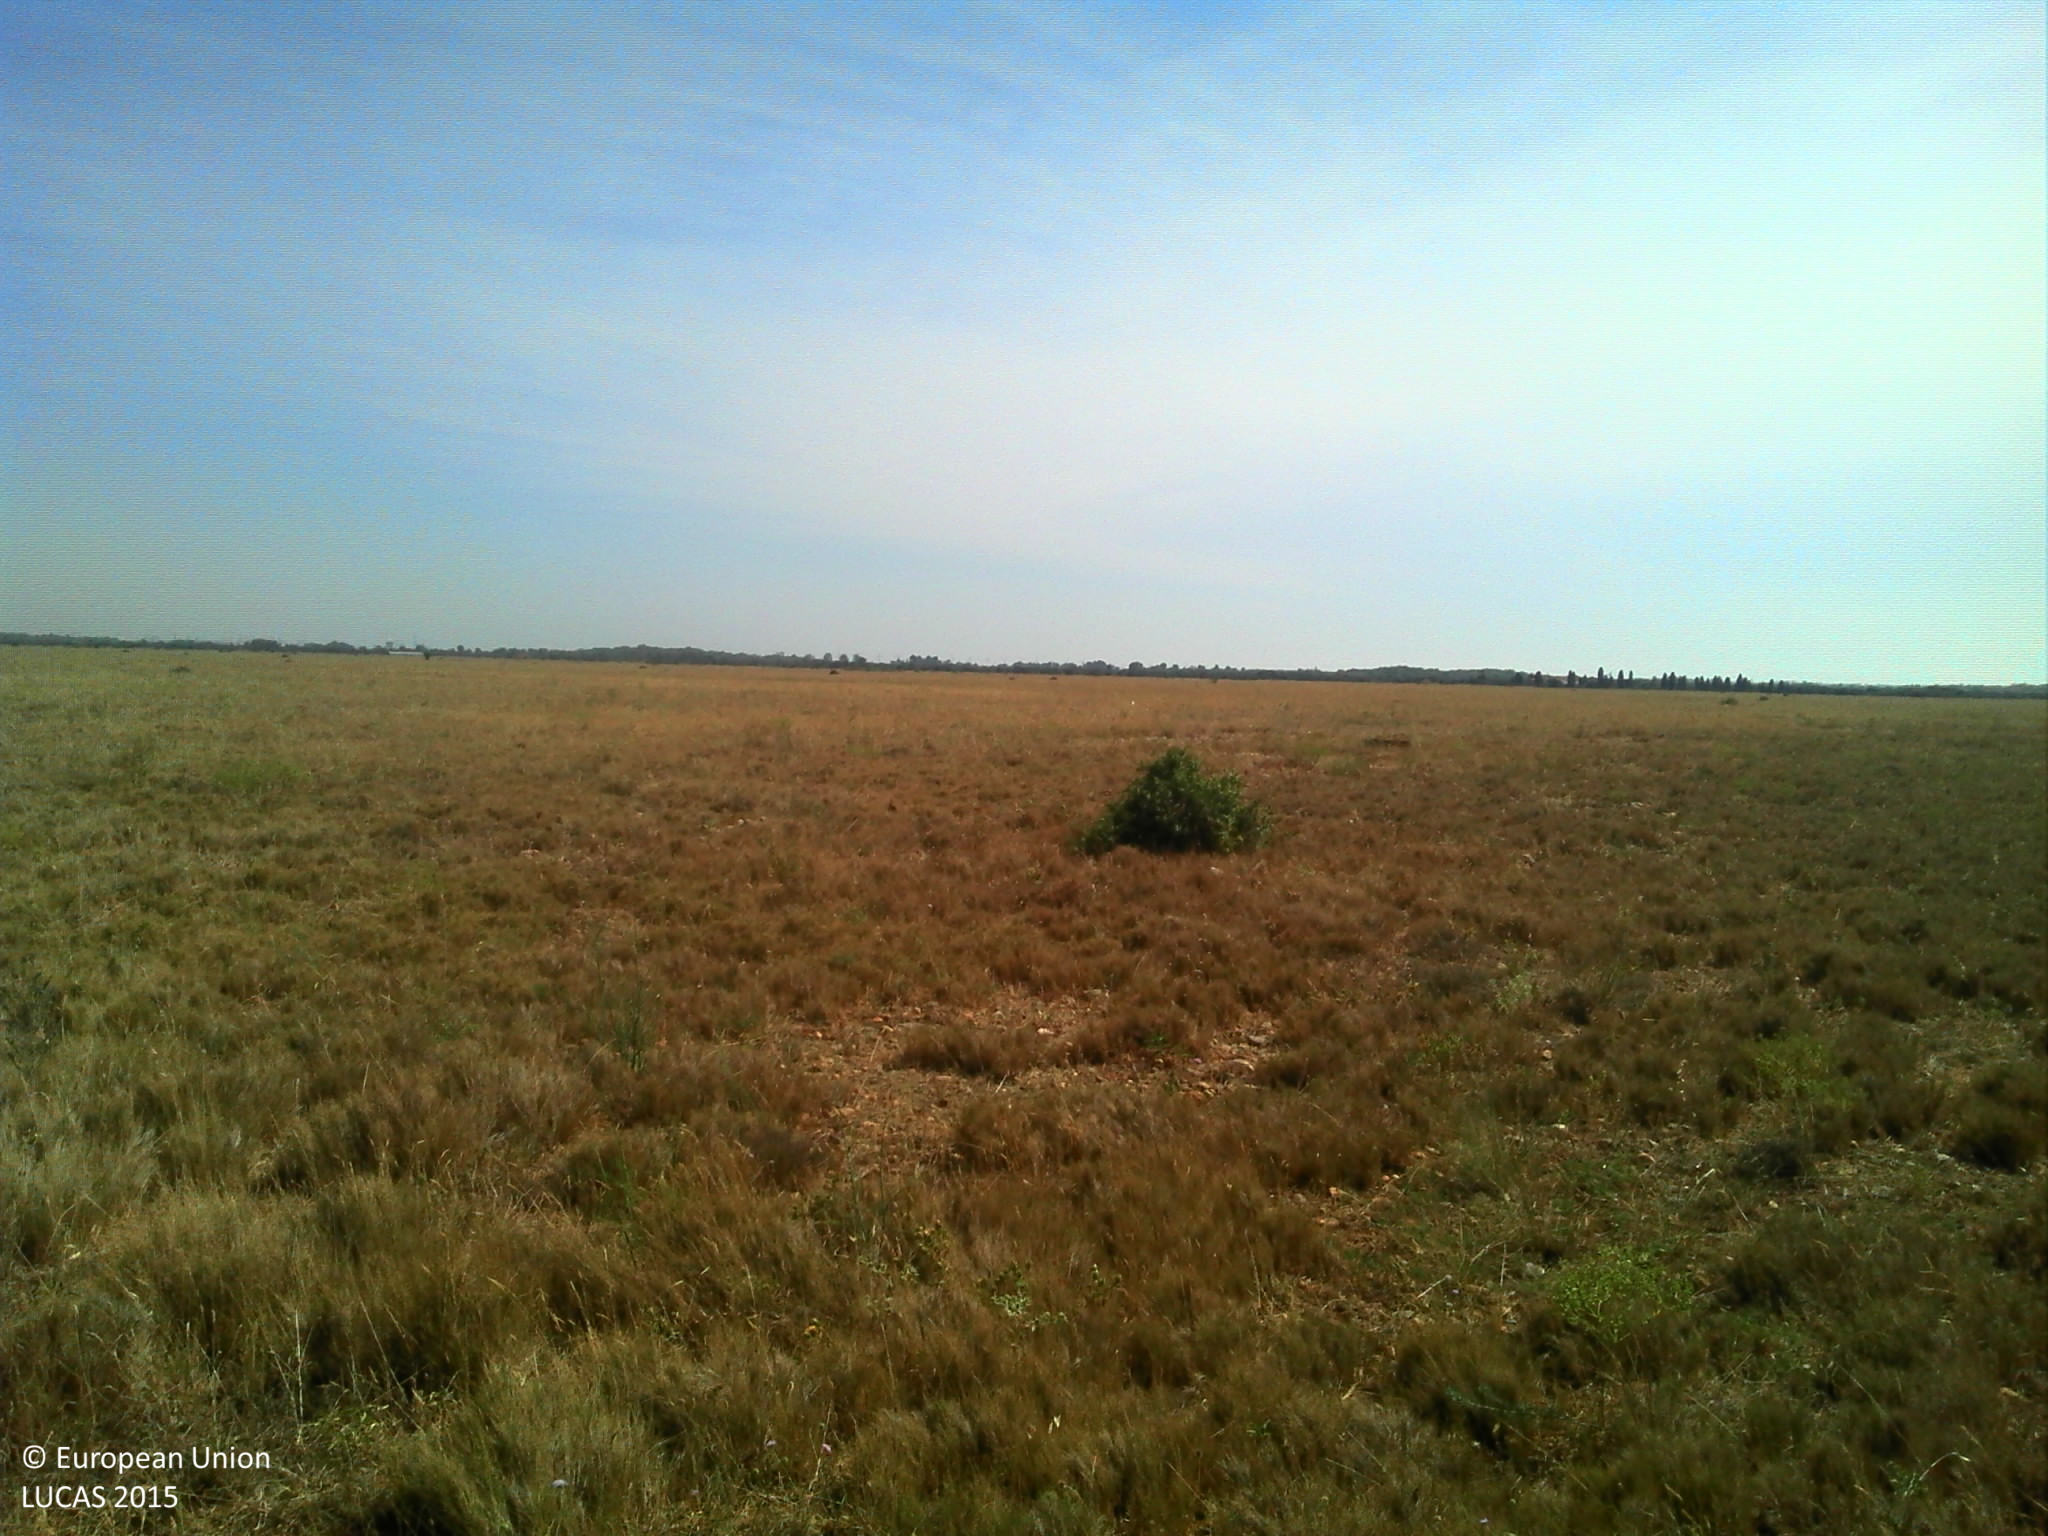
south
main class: Grassland
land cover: Grassland without tree/shrub cover
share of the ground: > 75 %
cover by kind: herbaceous plants 55 %, unconsolidated bare surface 45 %
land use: Agriculture (excluding fallow land and kitchen gardens)
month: July
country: FR
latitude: 43.5346
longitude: 4.8250
